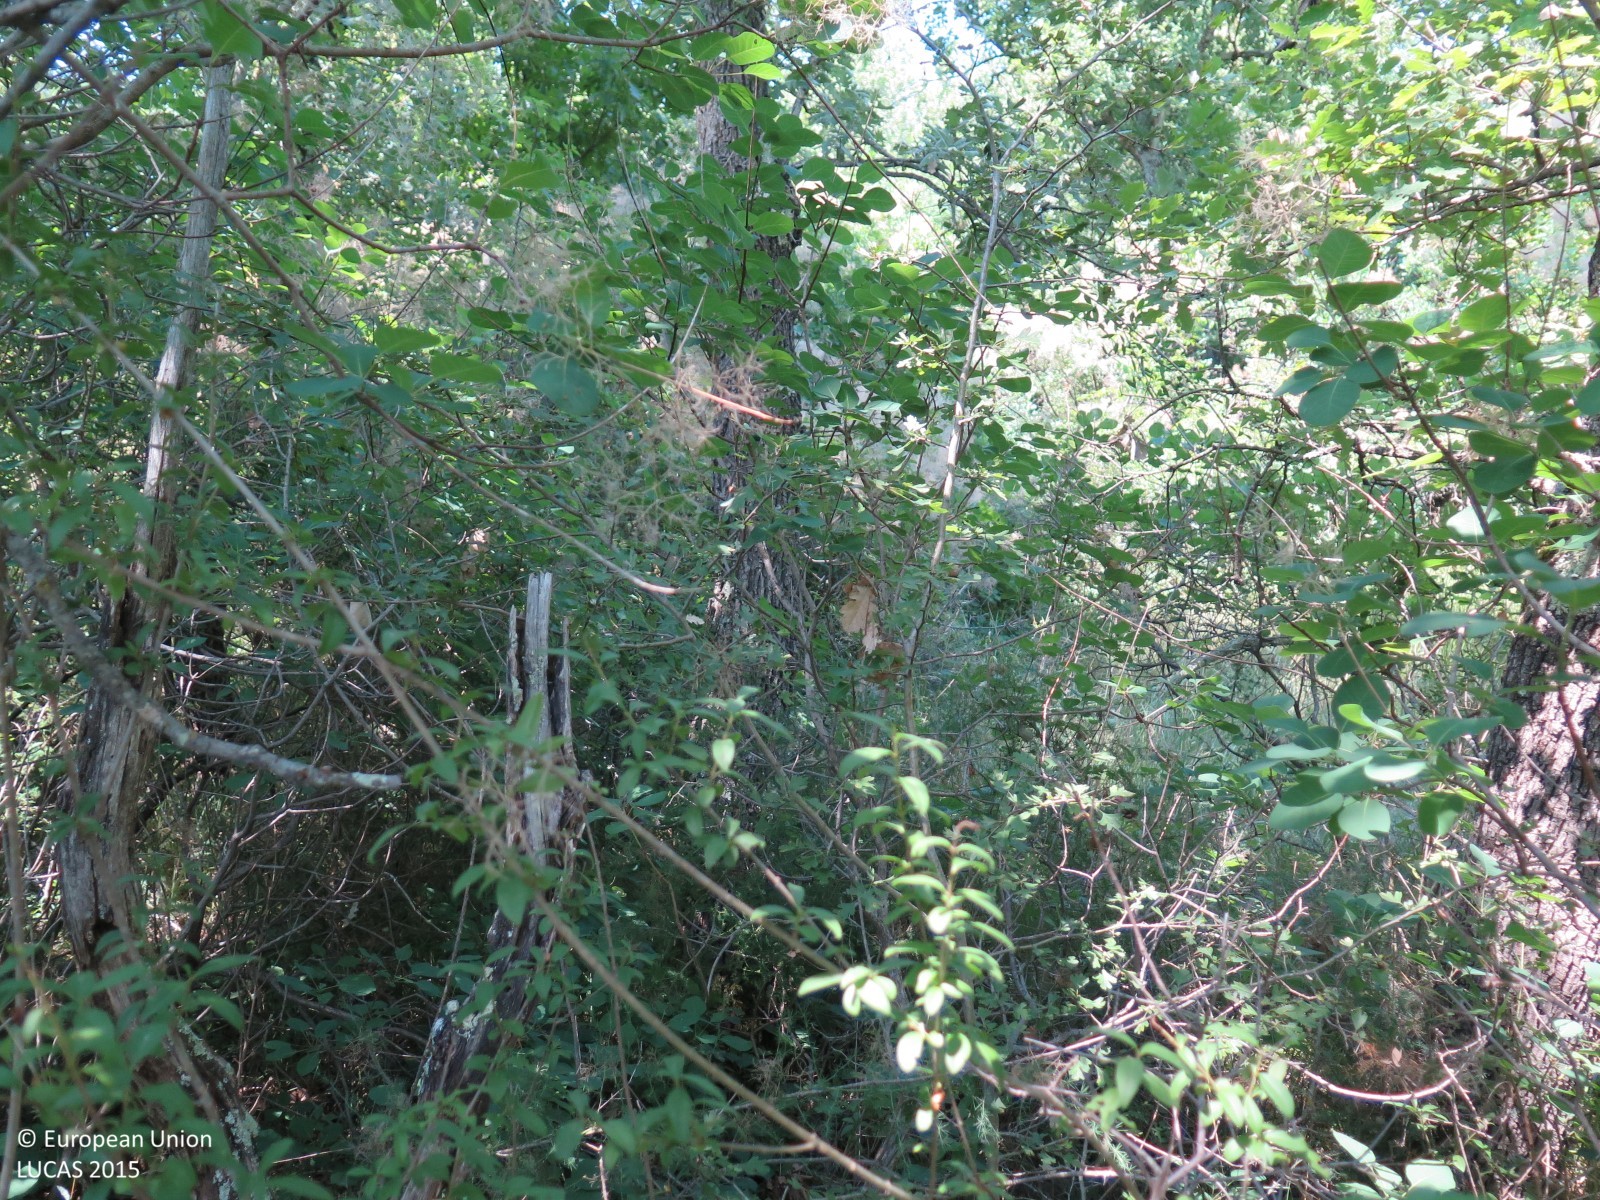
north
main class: Woodland
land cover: Broadleaved woodland
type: mesophytic deciduous forest
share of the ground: > 75 %
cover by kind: broadleaved forest trees 90 %, shrubs 5 %, herbaceous plants 5 %
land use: Semi-natural and natural areas not in use
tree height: > 5 m
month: July
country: HR
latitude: 45.4435
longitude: 13.5878
